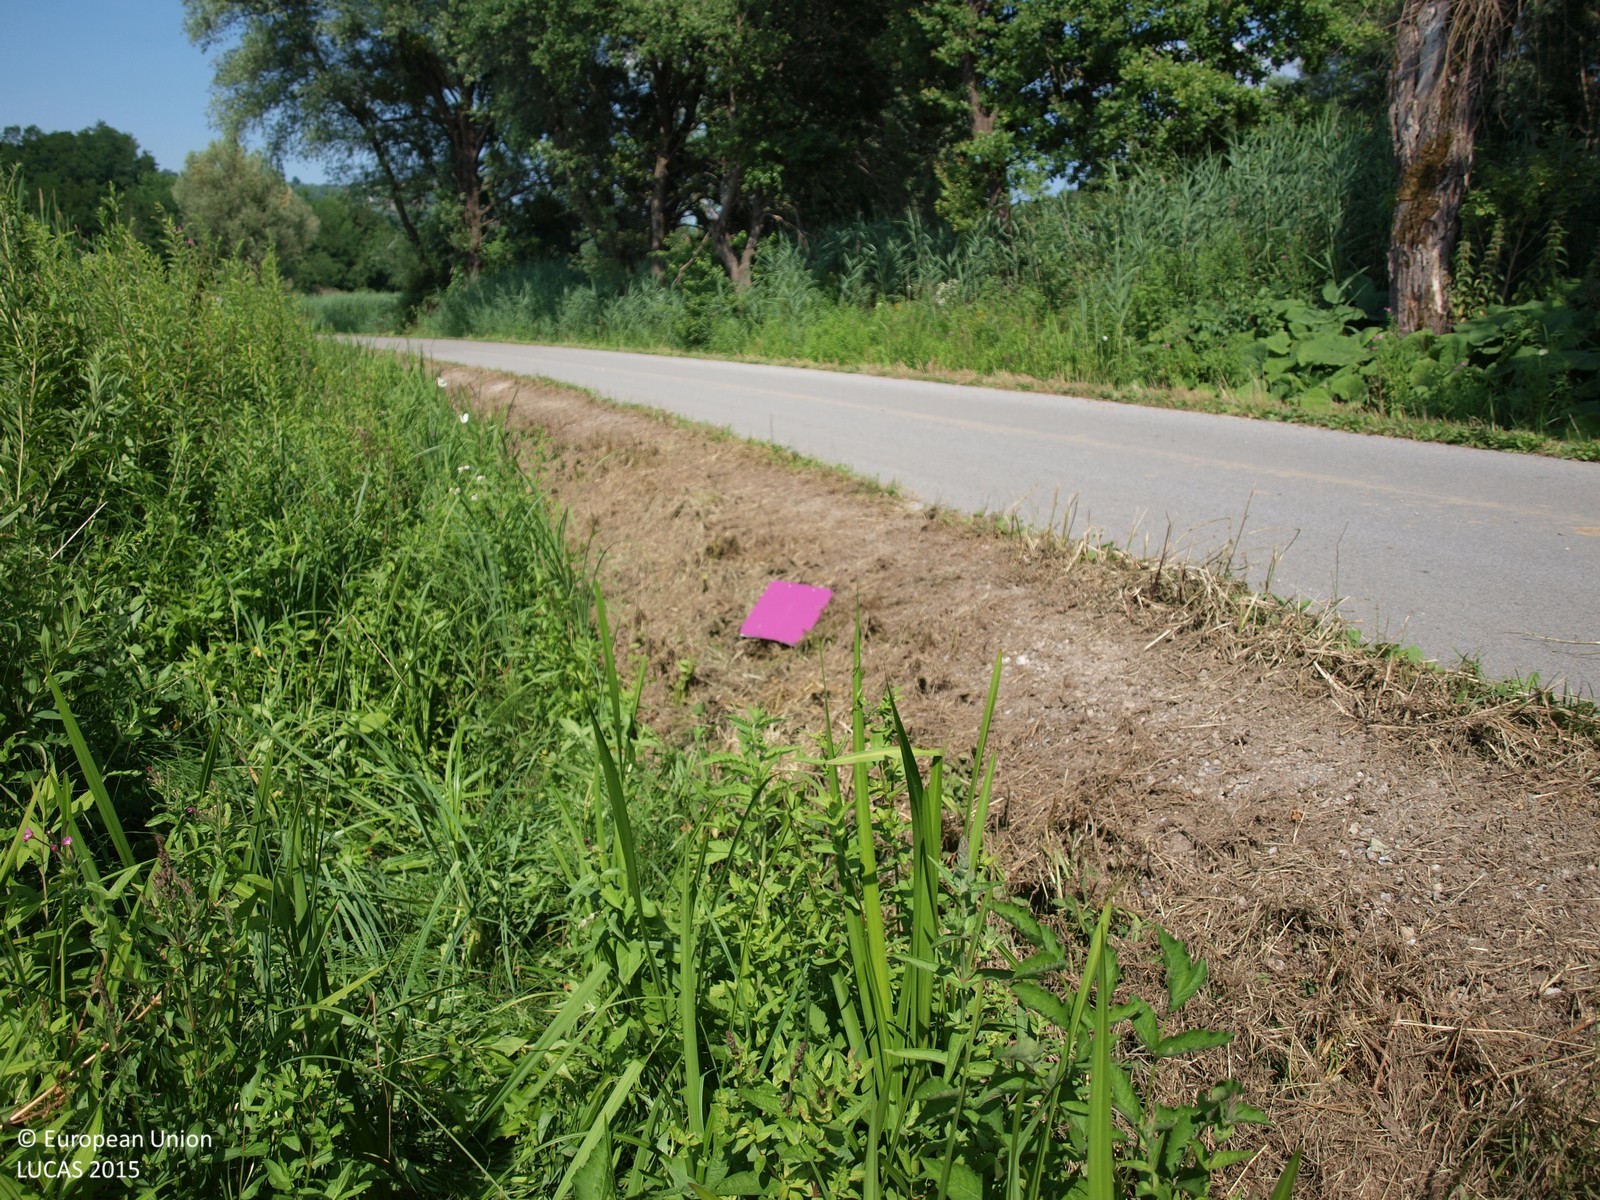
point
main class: Grassland
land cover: Grassland without tree/shrub cover
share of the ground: > 75 %
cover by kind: herbaceous plants 100 %
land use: Agriculture (excluding fallow land and kitchen gardens)
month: July
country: HR
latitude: 46.1485
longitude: 15.9674
